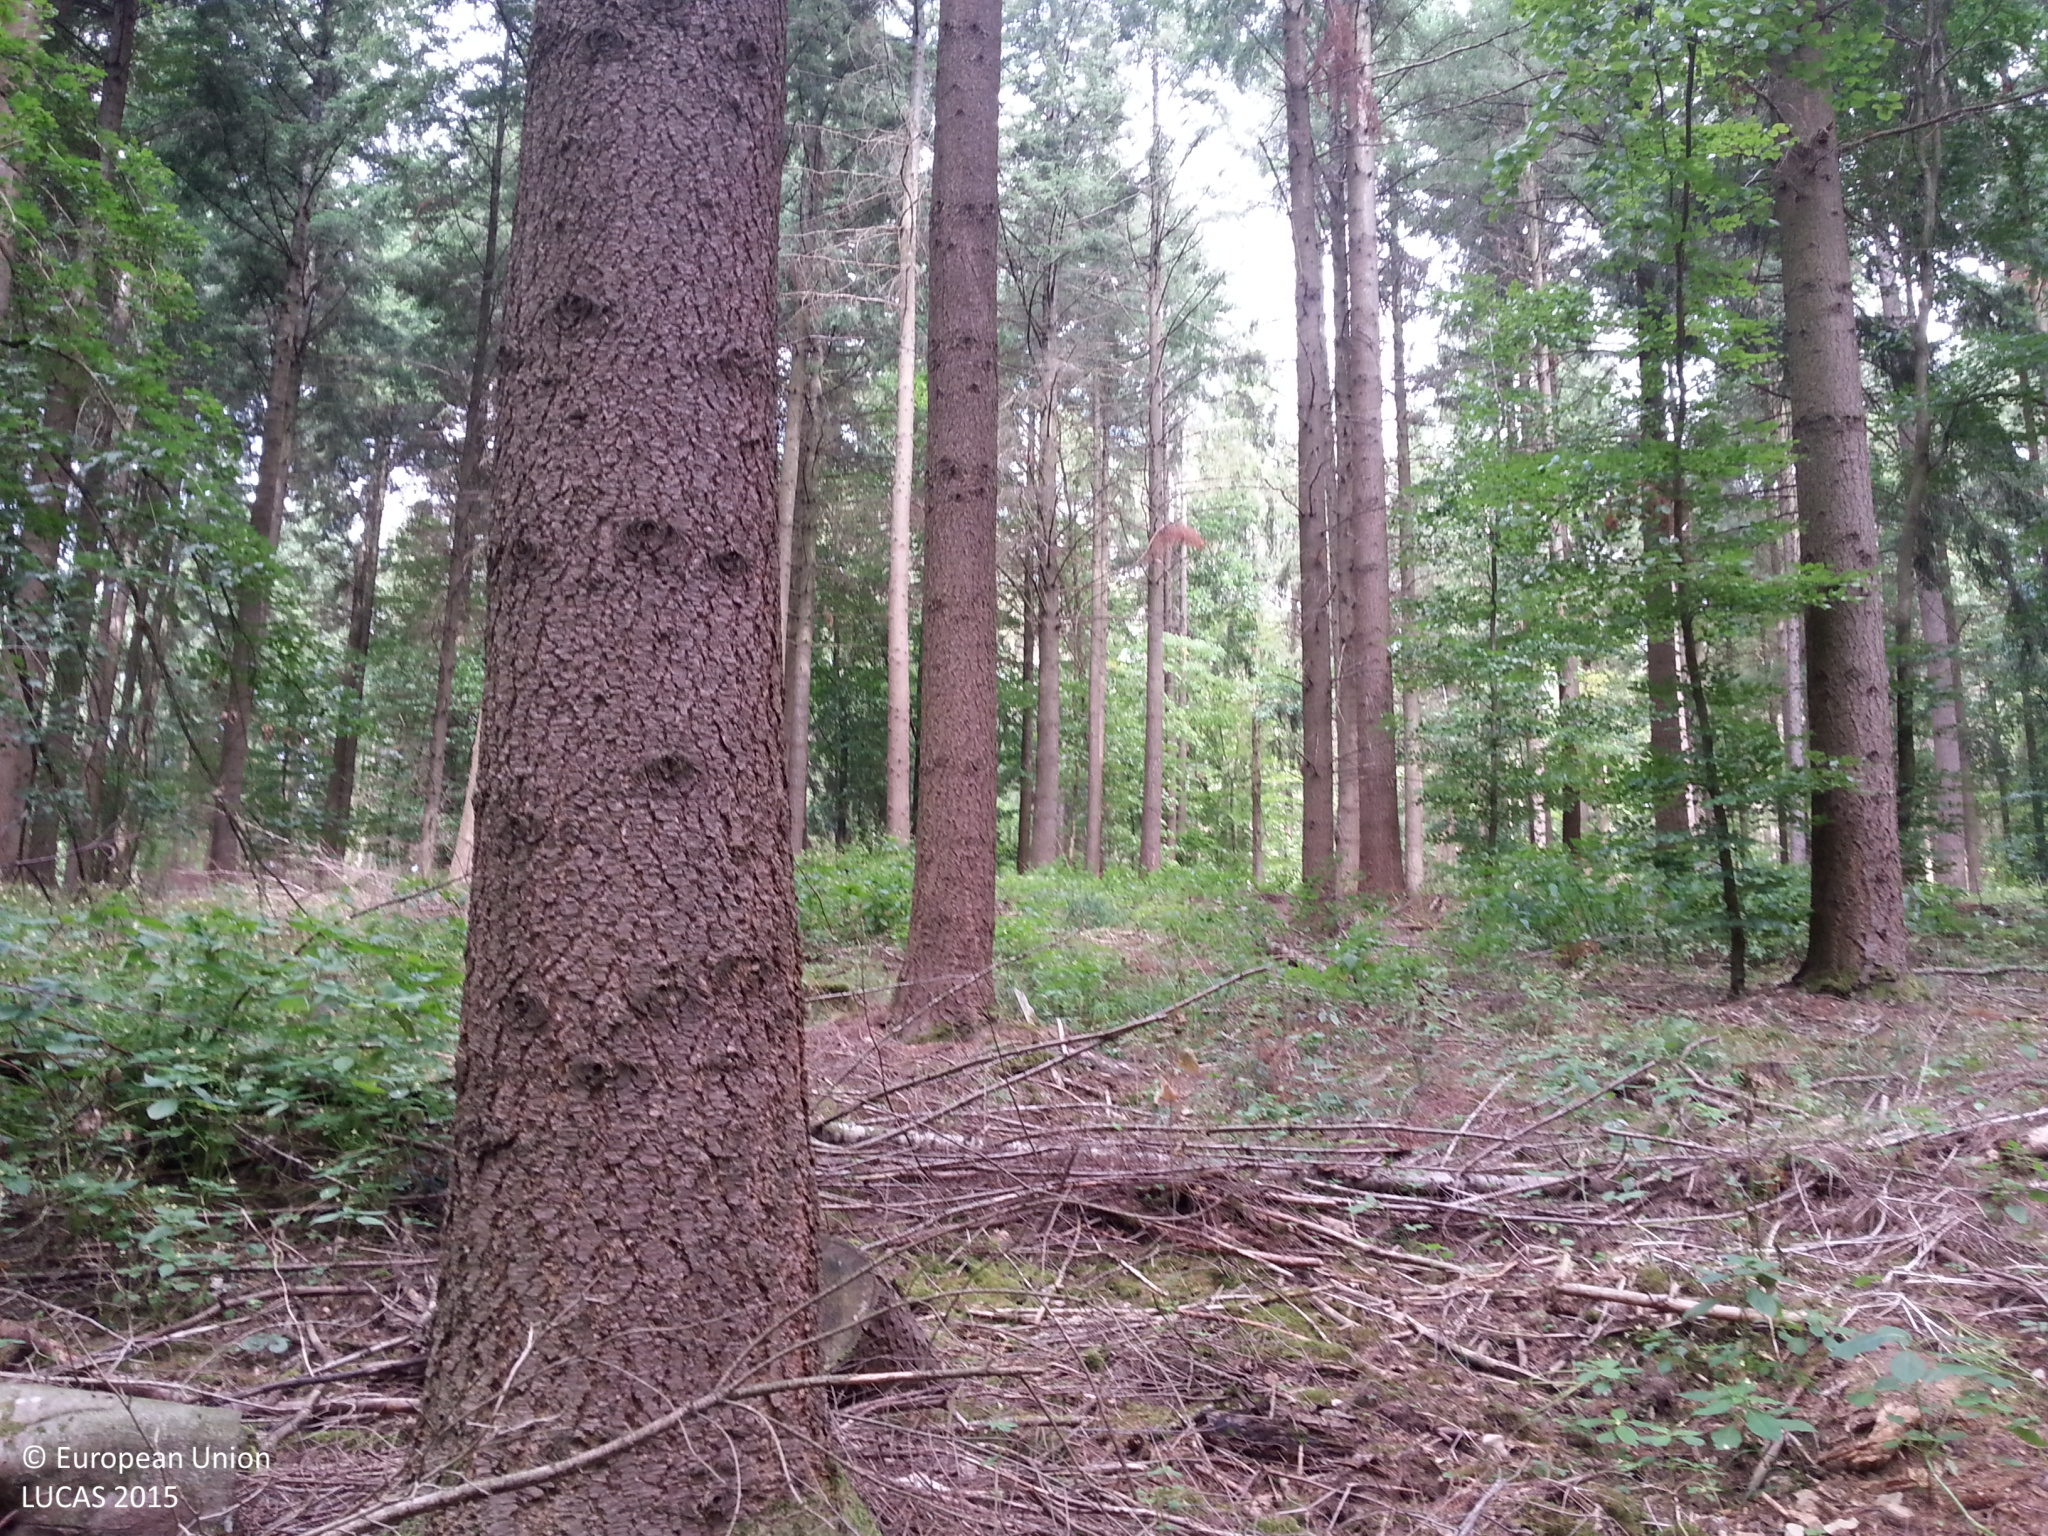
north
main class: Woodland
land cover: Spruce dominated coniferous woodland
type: boreal forest
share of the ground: > 75 %
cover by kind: coniferous forest trees 65 %, broadleaved forest trees 15 %, lichens and mosses 10 %, herbaceous plants 5 %, unconsolidated bare surface 5 %
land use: Forestry
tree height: > 5 m
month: September
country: DE
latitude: 49.4453
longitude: 9.4071
